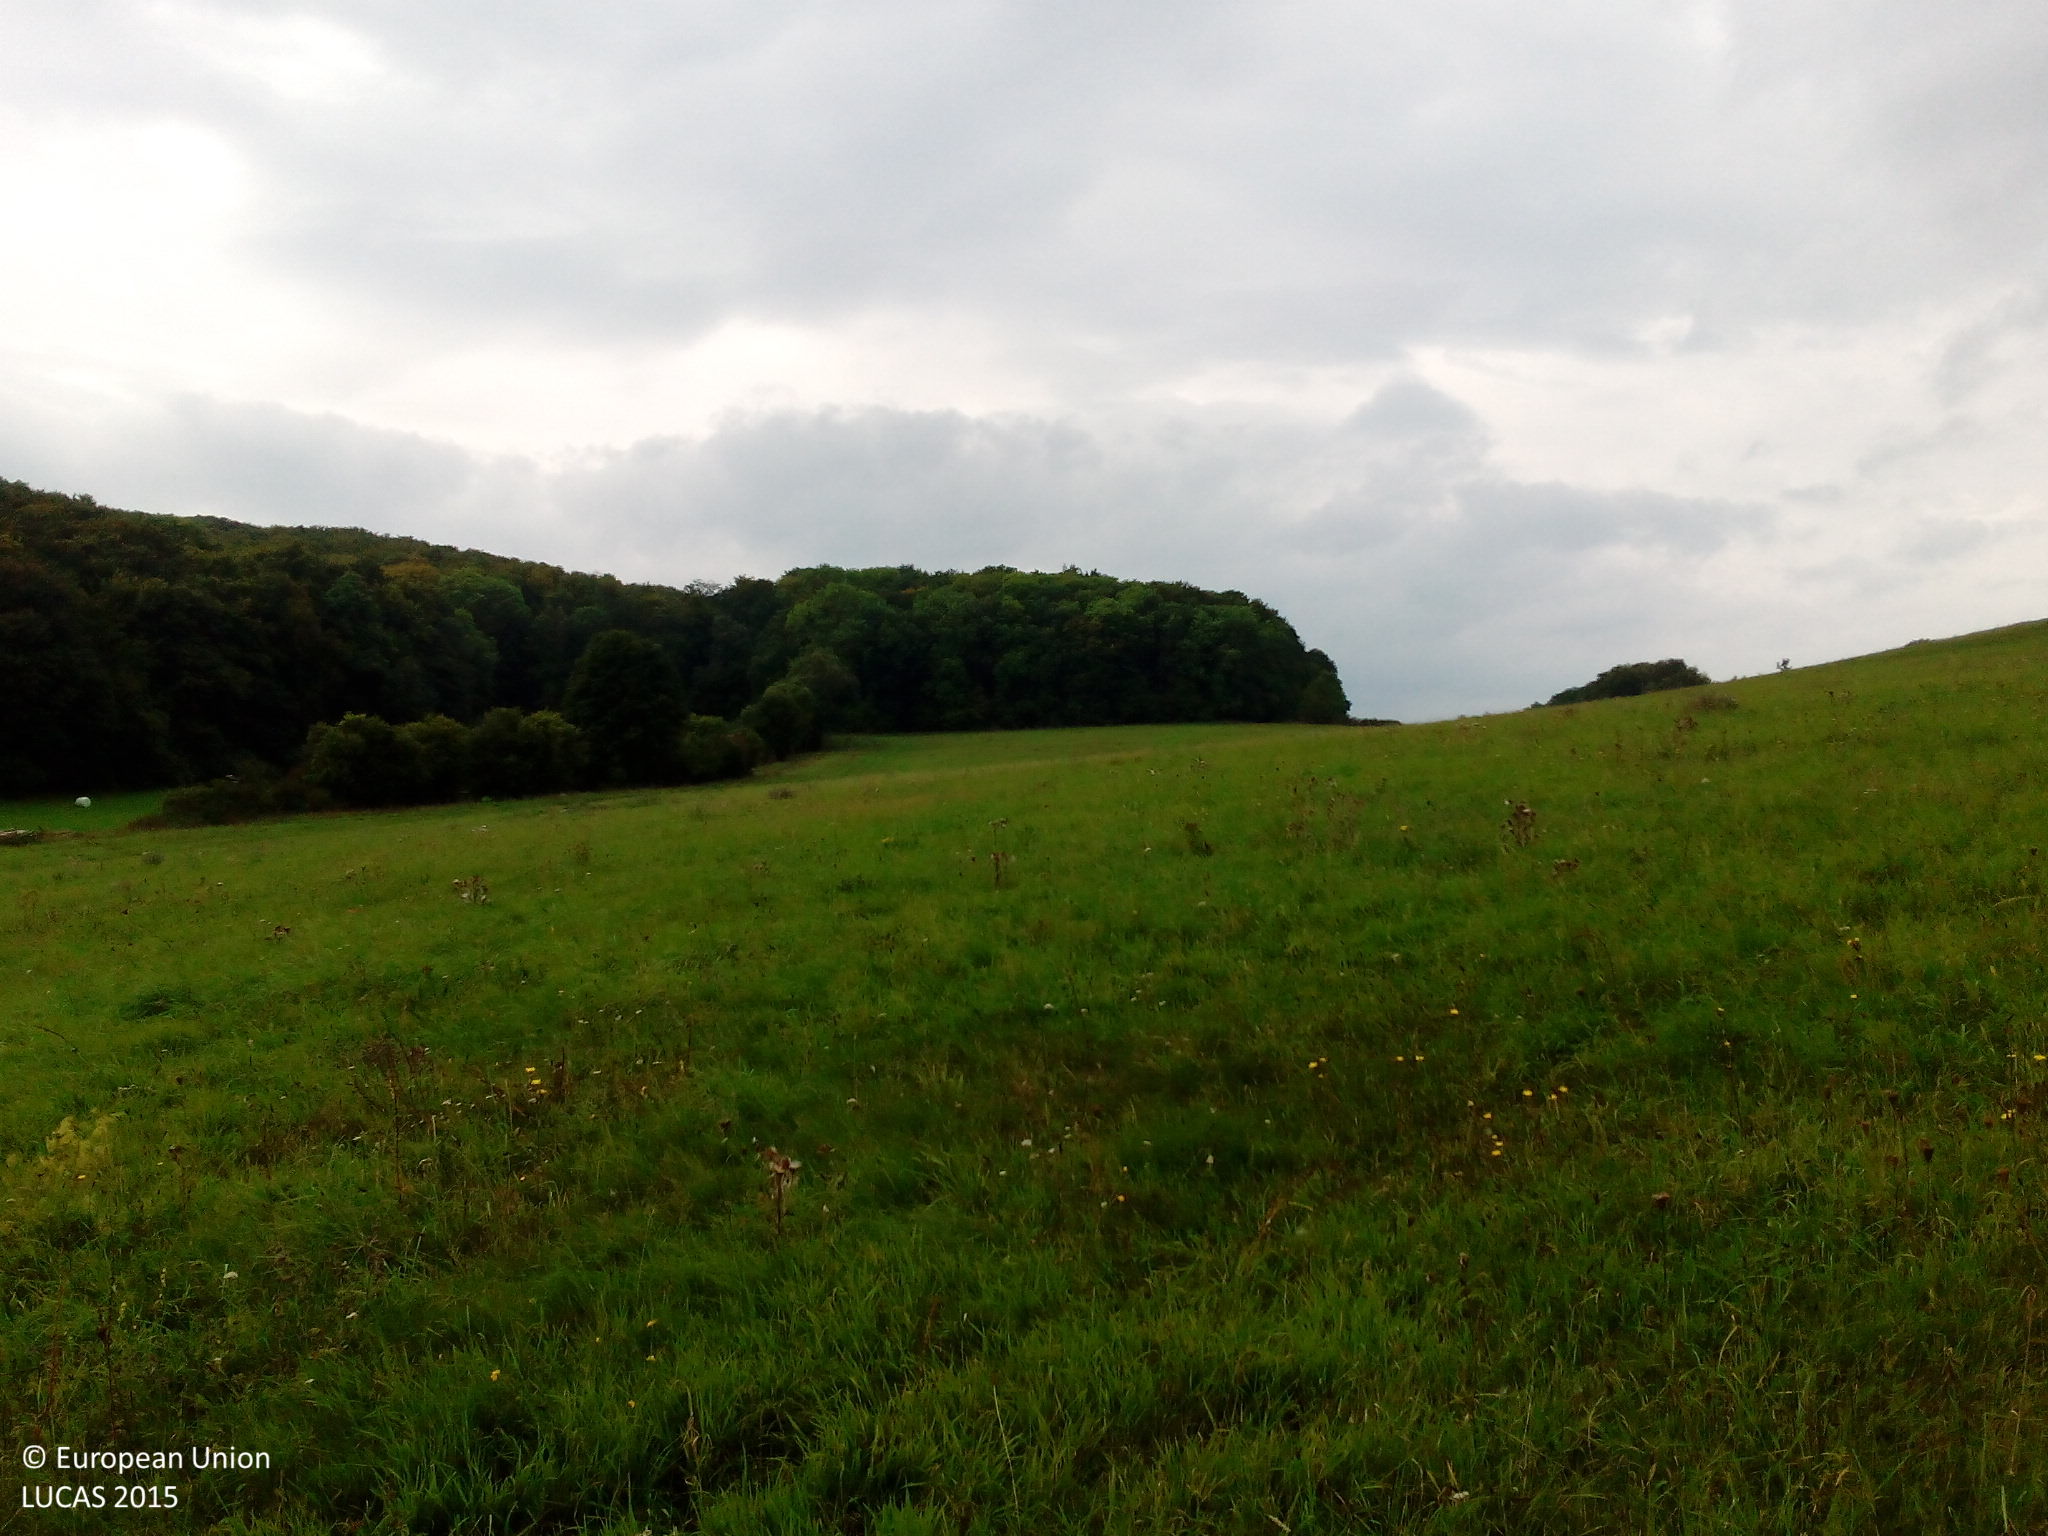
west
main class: Grassland
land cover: Grassland without tree/shrub cover
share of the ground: > 75 %
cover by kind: herbaceous plants 100 %
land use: Agriculture (excluding fallow land and kitchen gardens)
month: September
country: DE
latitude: 51.4922
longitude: 11.0223
